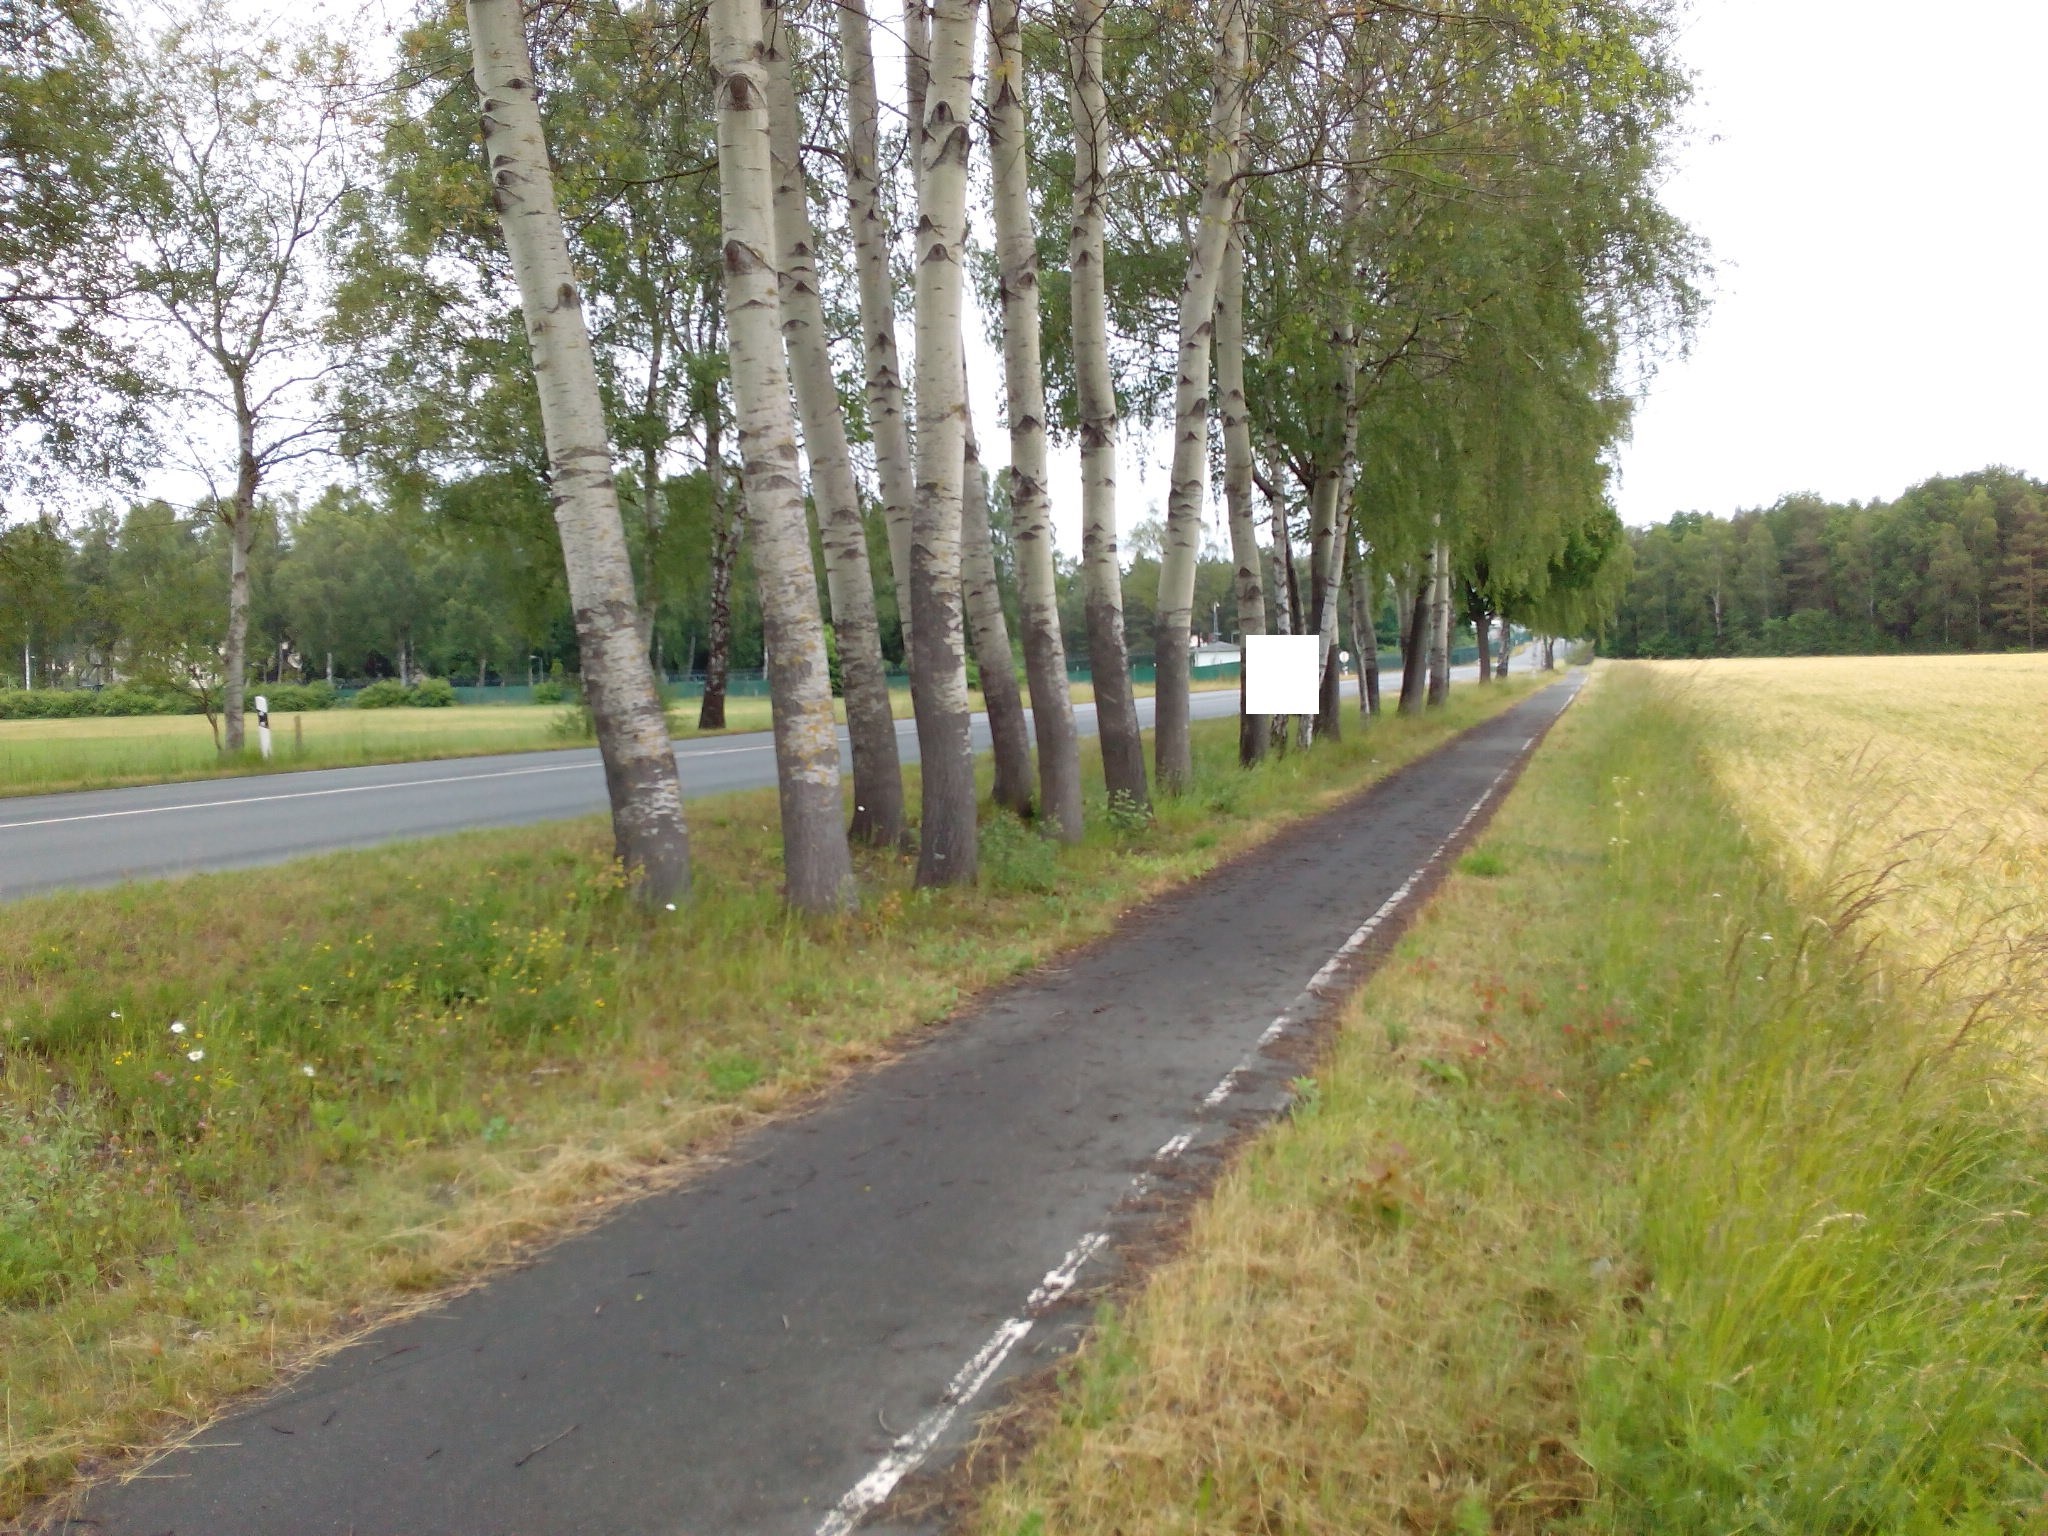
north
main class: Cropland
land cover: Barley
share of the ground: > 75 %
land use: Agriculture (excluding fallow land and kitchen gardens)
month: June
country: DE
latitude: 52.7728
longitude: 9.9259
